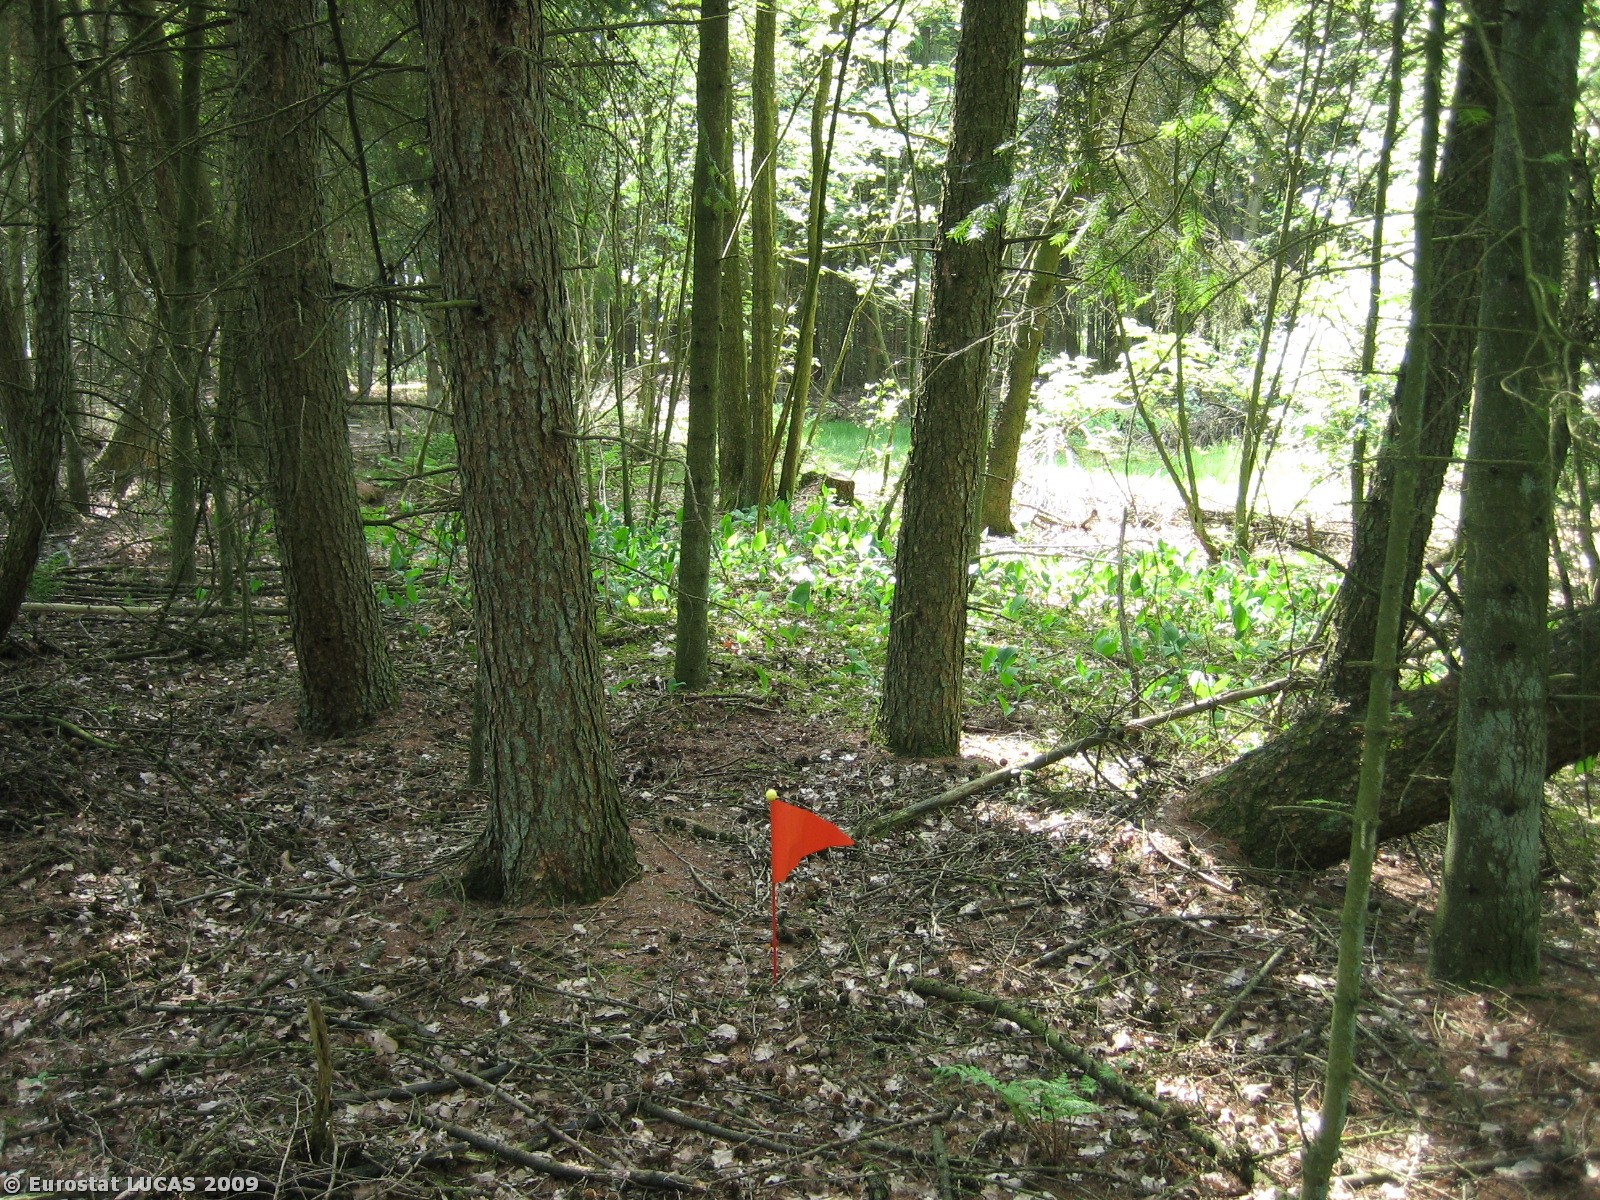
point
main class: Woodland
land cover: Mixed woodland
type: mesophytic deciduous forest
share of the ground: > 75 %
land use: Forestry
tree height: > 5 m
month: May
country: DK
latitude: 56.0954
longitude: 9.2133
